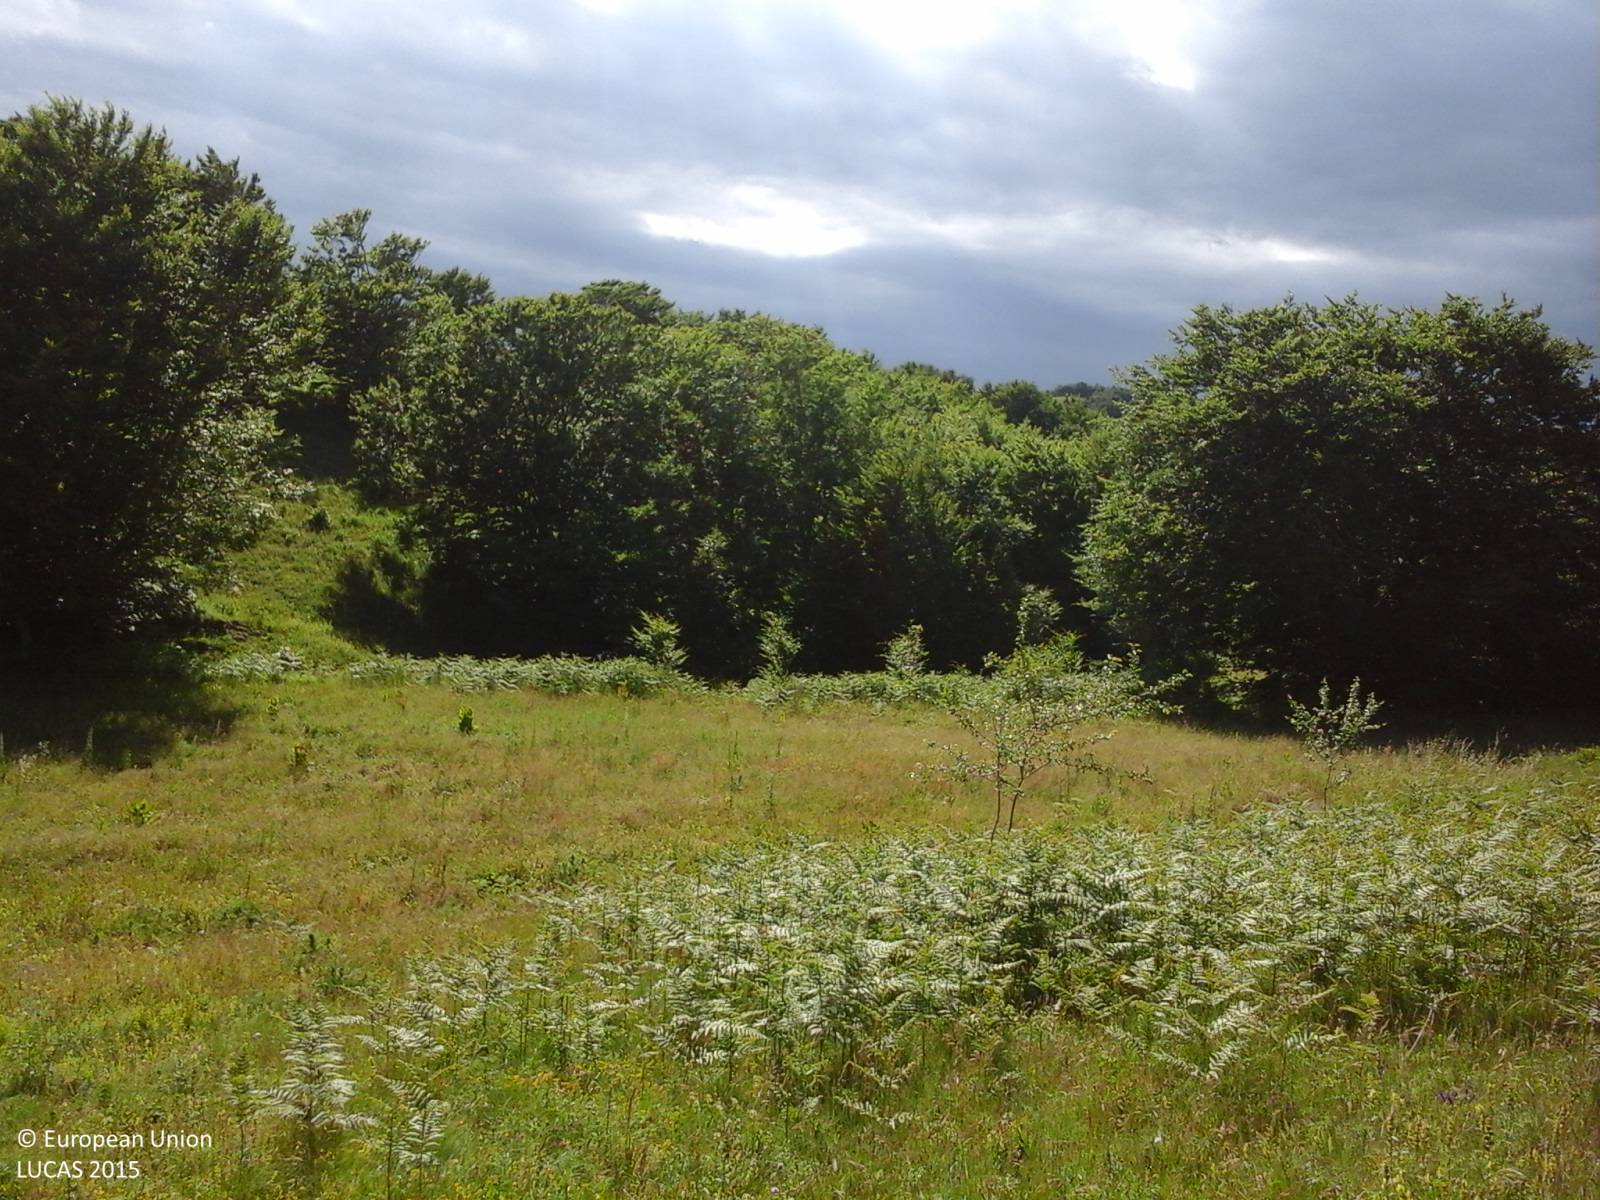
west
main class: Grassland
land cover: Grassland without tree/shrub cover
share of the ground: > 75 %
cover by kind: herbaceous plants 100 %
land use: Agriculture (excluding fallow land and kitchen gardens)
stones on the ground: 25 - 50 %
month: June
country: IT
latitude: 41.4016
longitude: 14.3737
